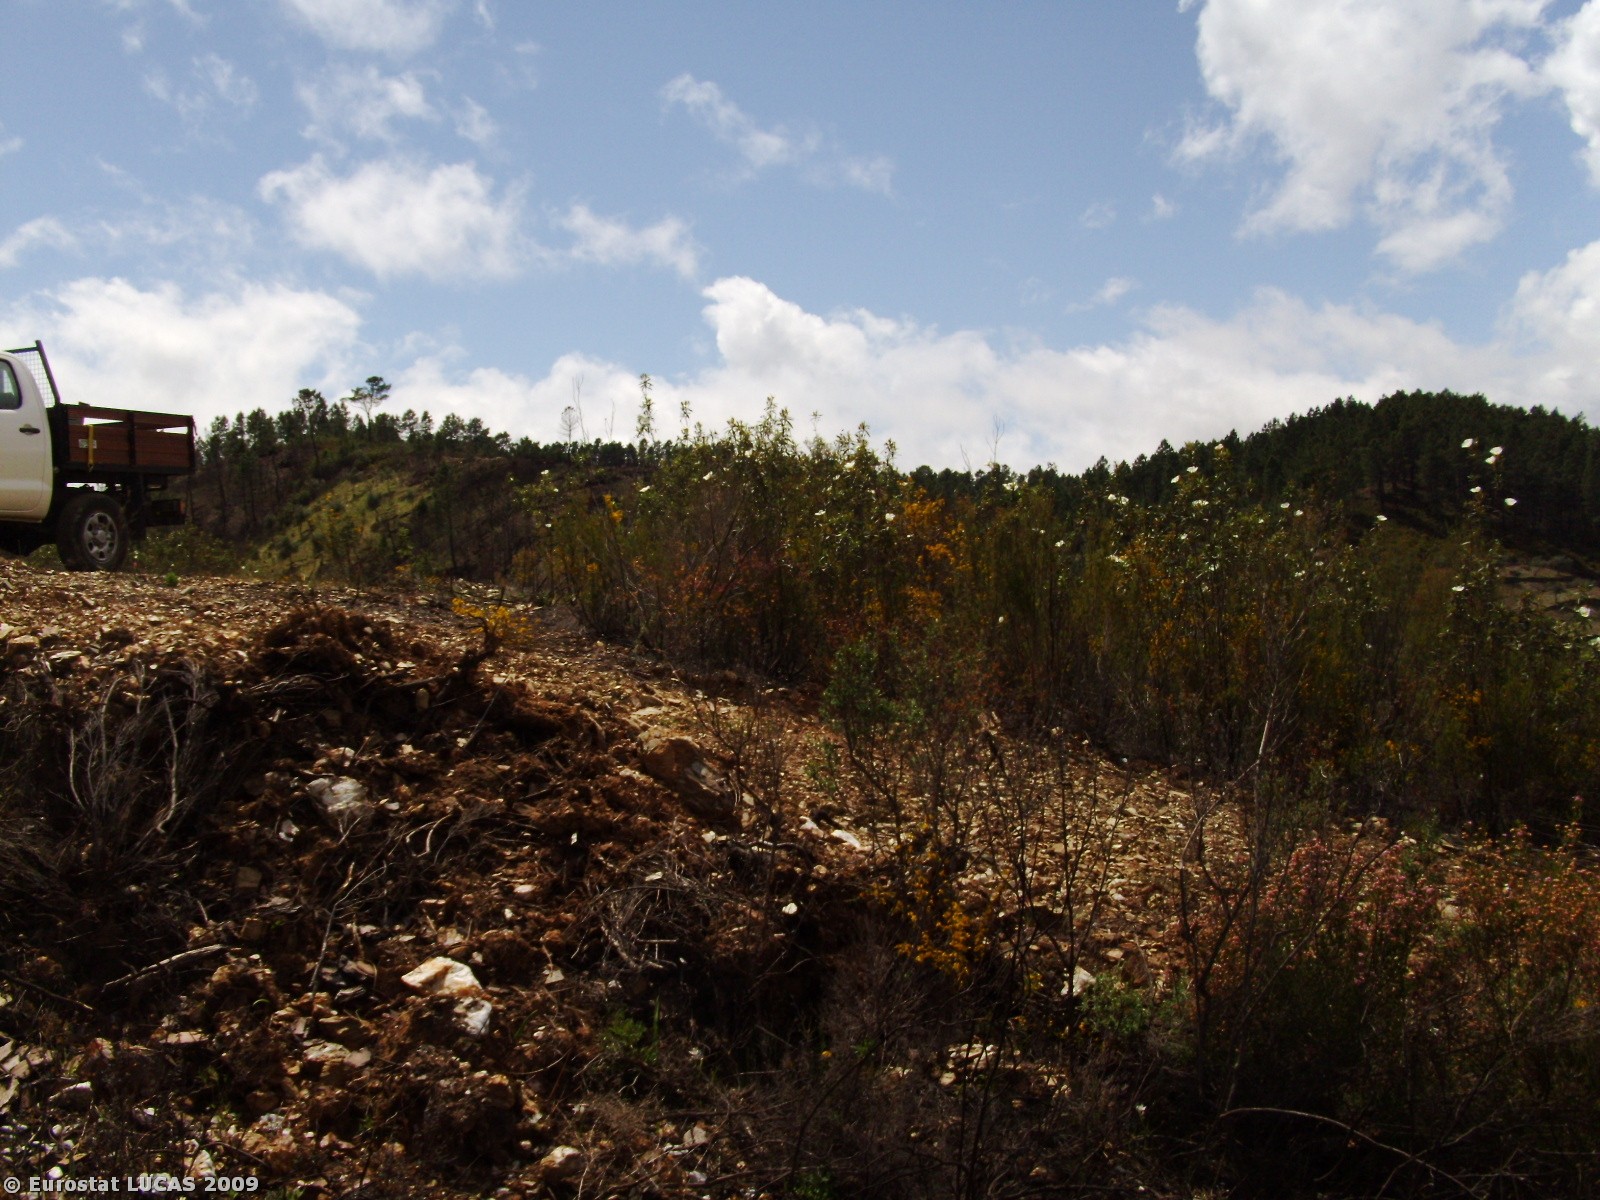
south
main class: Woodland
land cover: Coniferous woodland
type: coniferous forest of the mediterranean region
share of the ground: 50 - 75 %
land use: Forestry
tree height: > 5 m
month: April
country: PT
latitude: 39.8226
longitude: -7.6150
